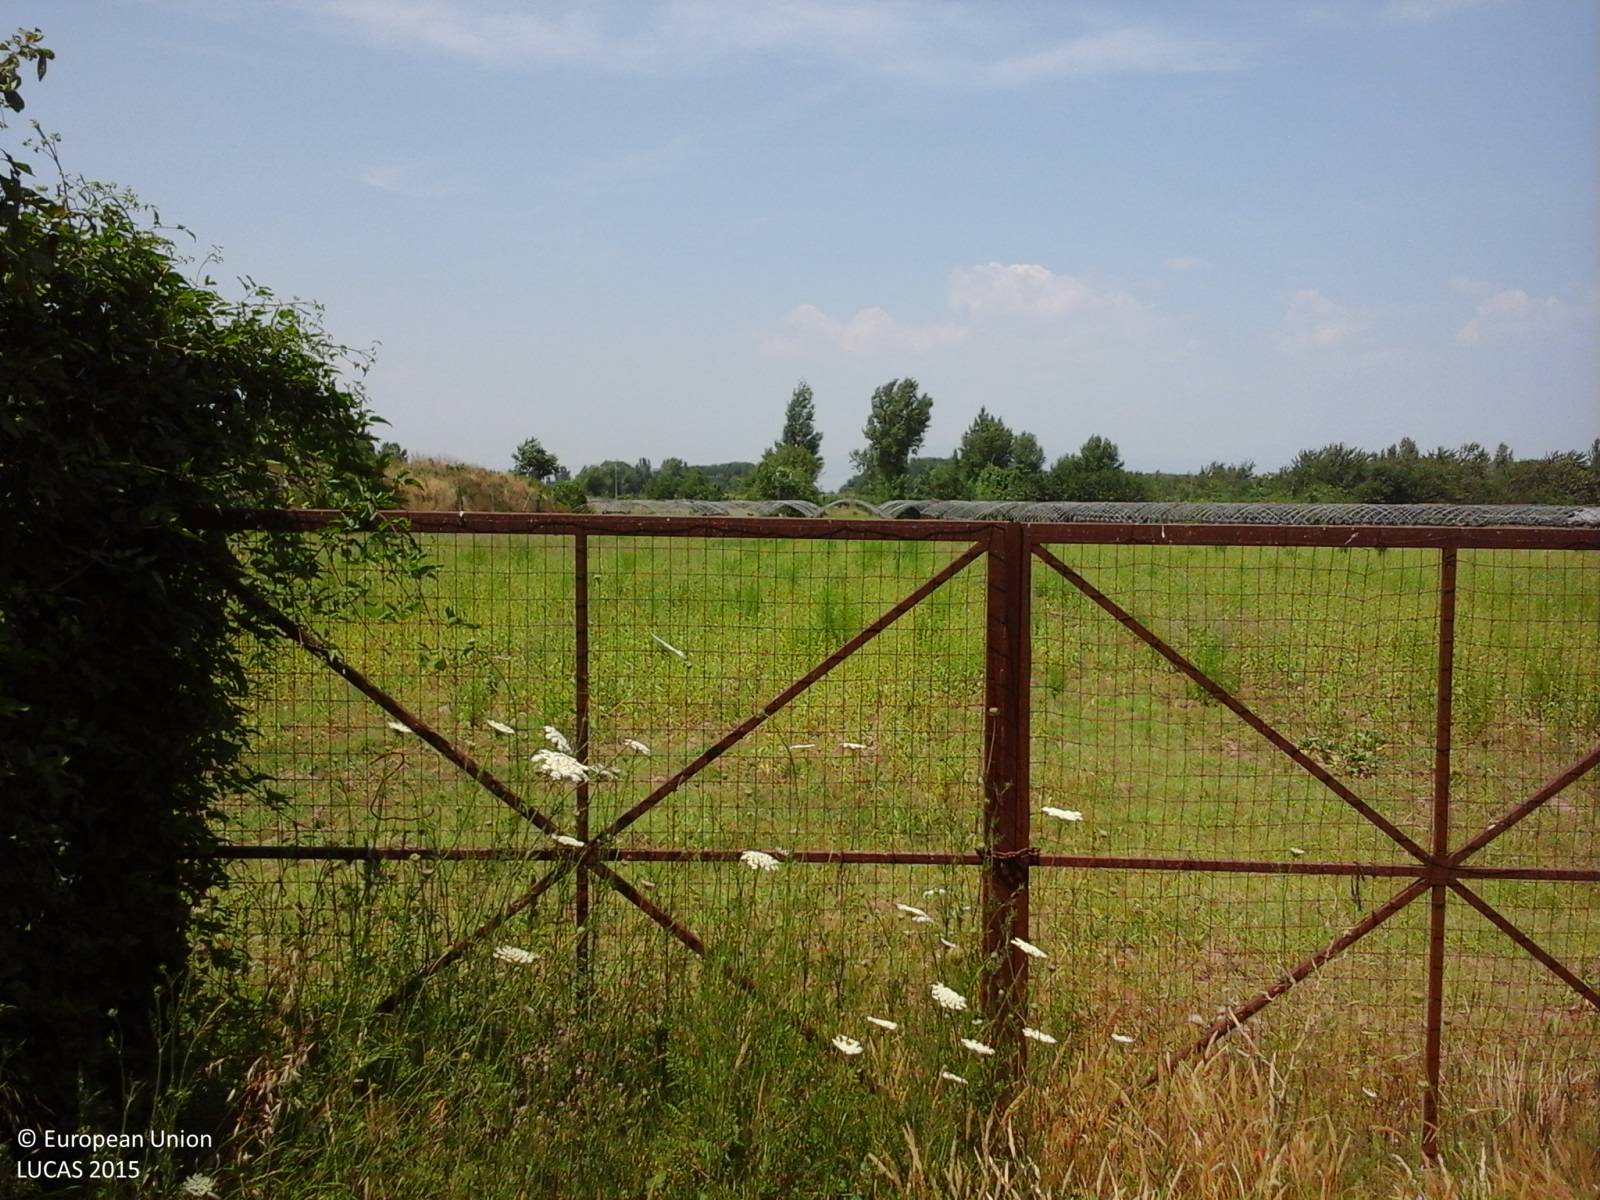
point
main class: Grassland
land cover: Spontaneously vegetated surfaces
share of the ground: > 75 %
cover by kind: herbaceous plants 100 %
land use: Agriculture (excluding fallow land and kitchen gardens)
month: July
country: IT
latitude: 40.9764
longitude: 14.1543
